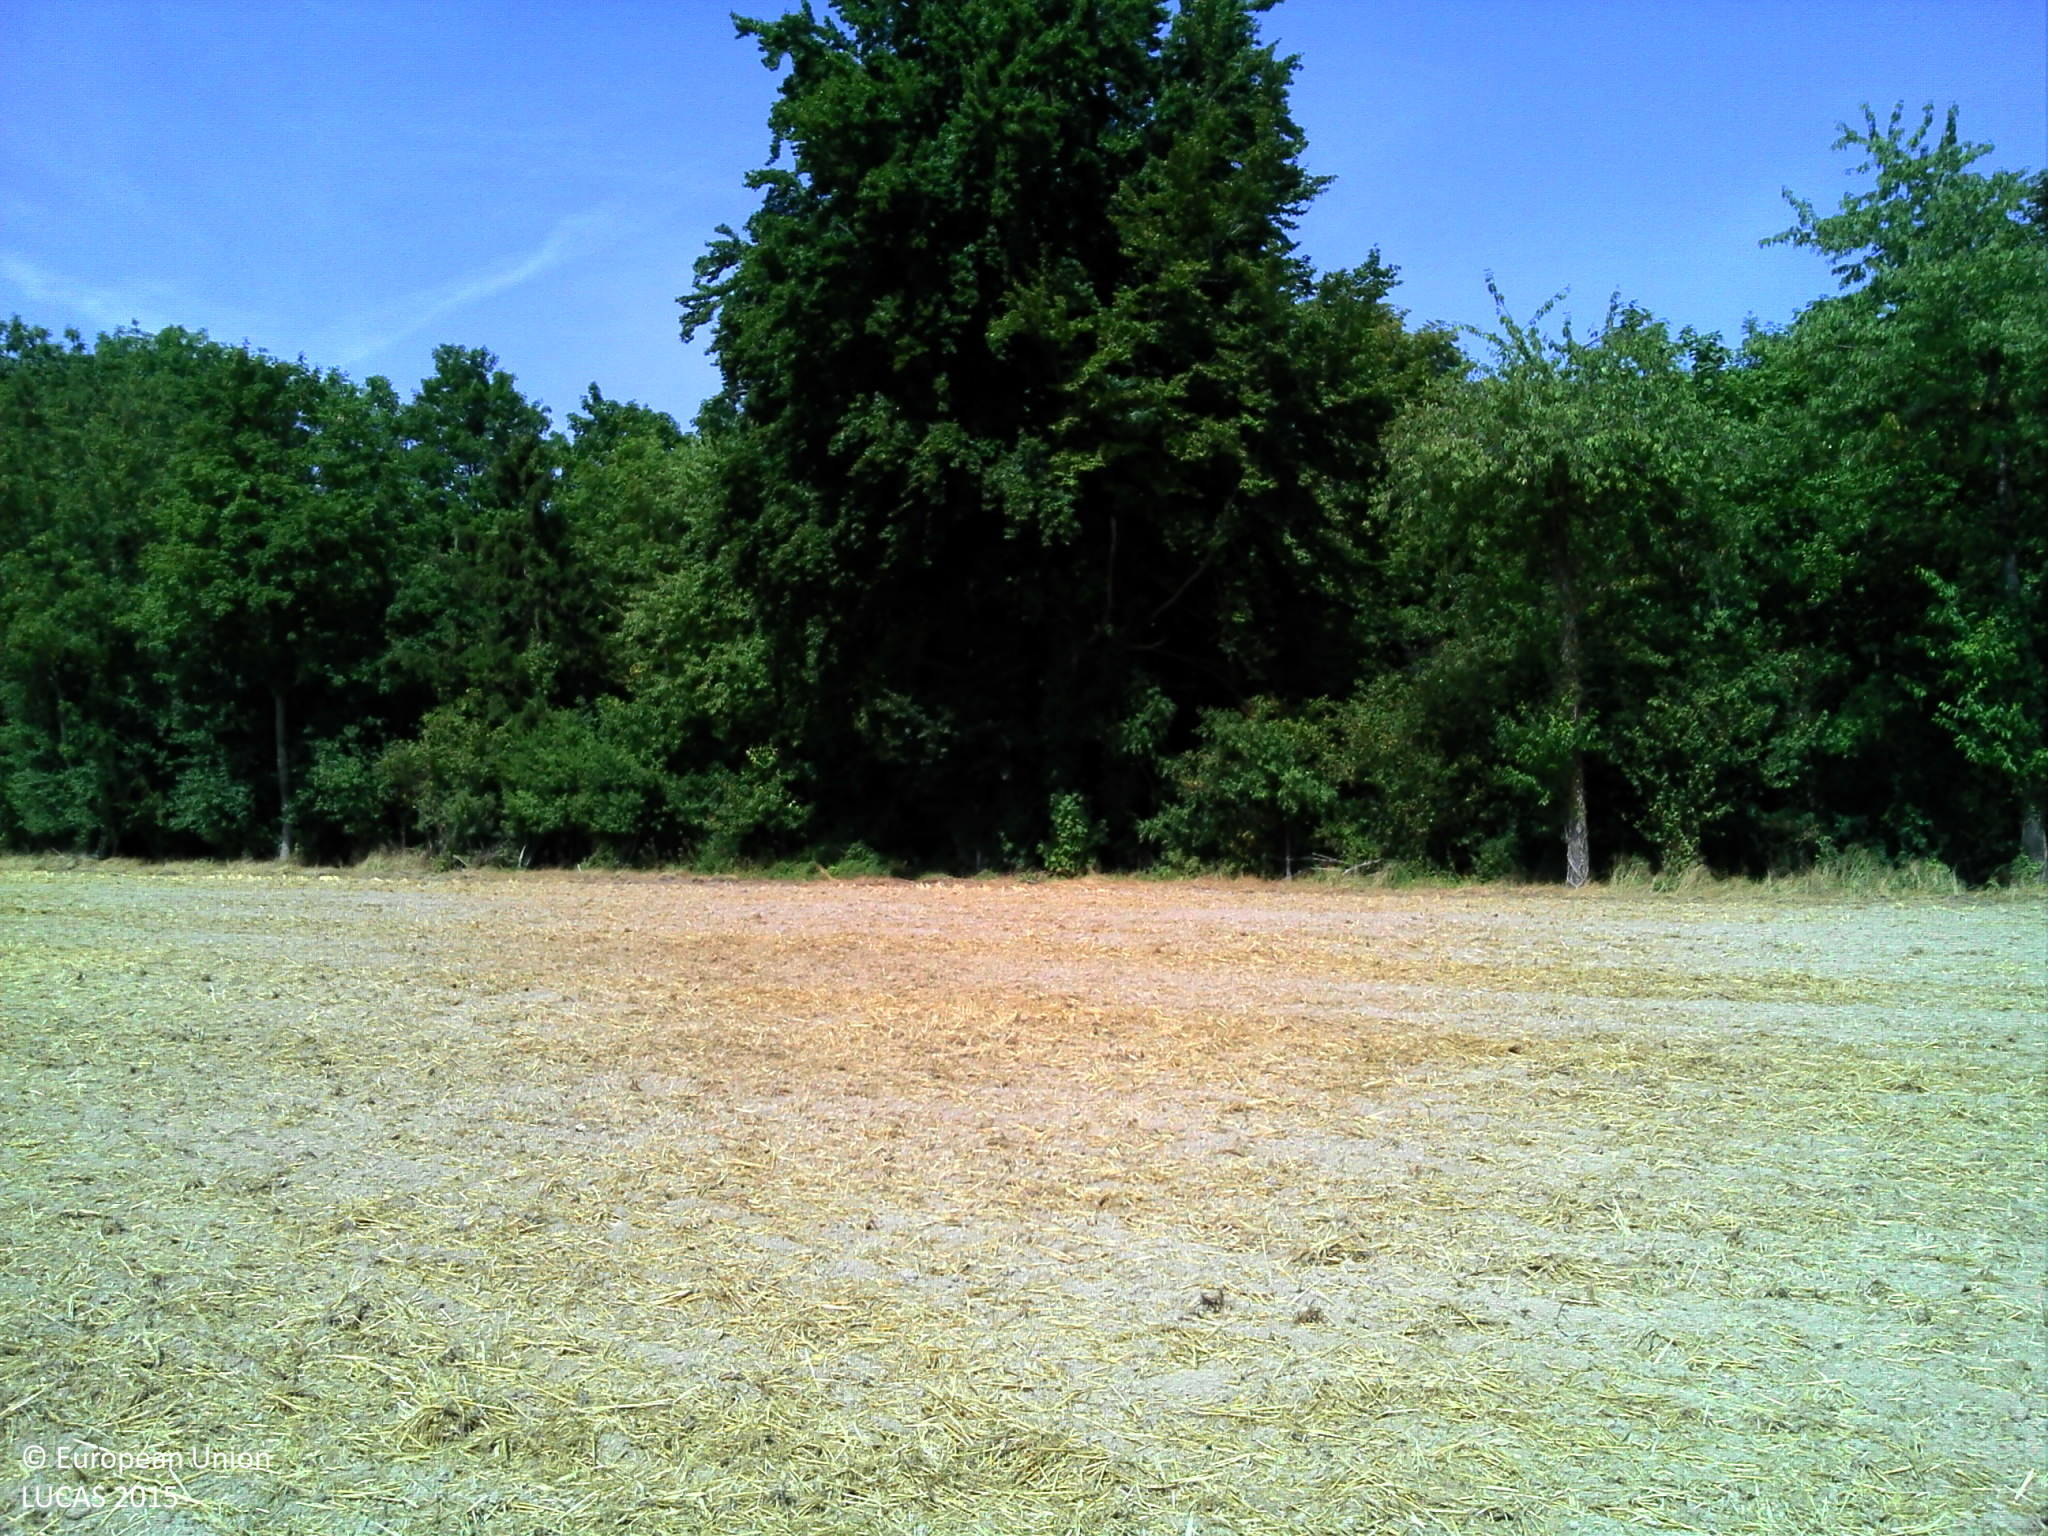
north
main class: Cropland
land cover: Common wheat
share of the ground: > 75 %
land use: Agriculture (excluding fallow land and kitchen gardens)
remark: Harvested field
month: August
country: FR
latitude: 48.9722
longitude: 4.1898
